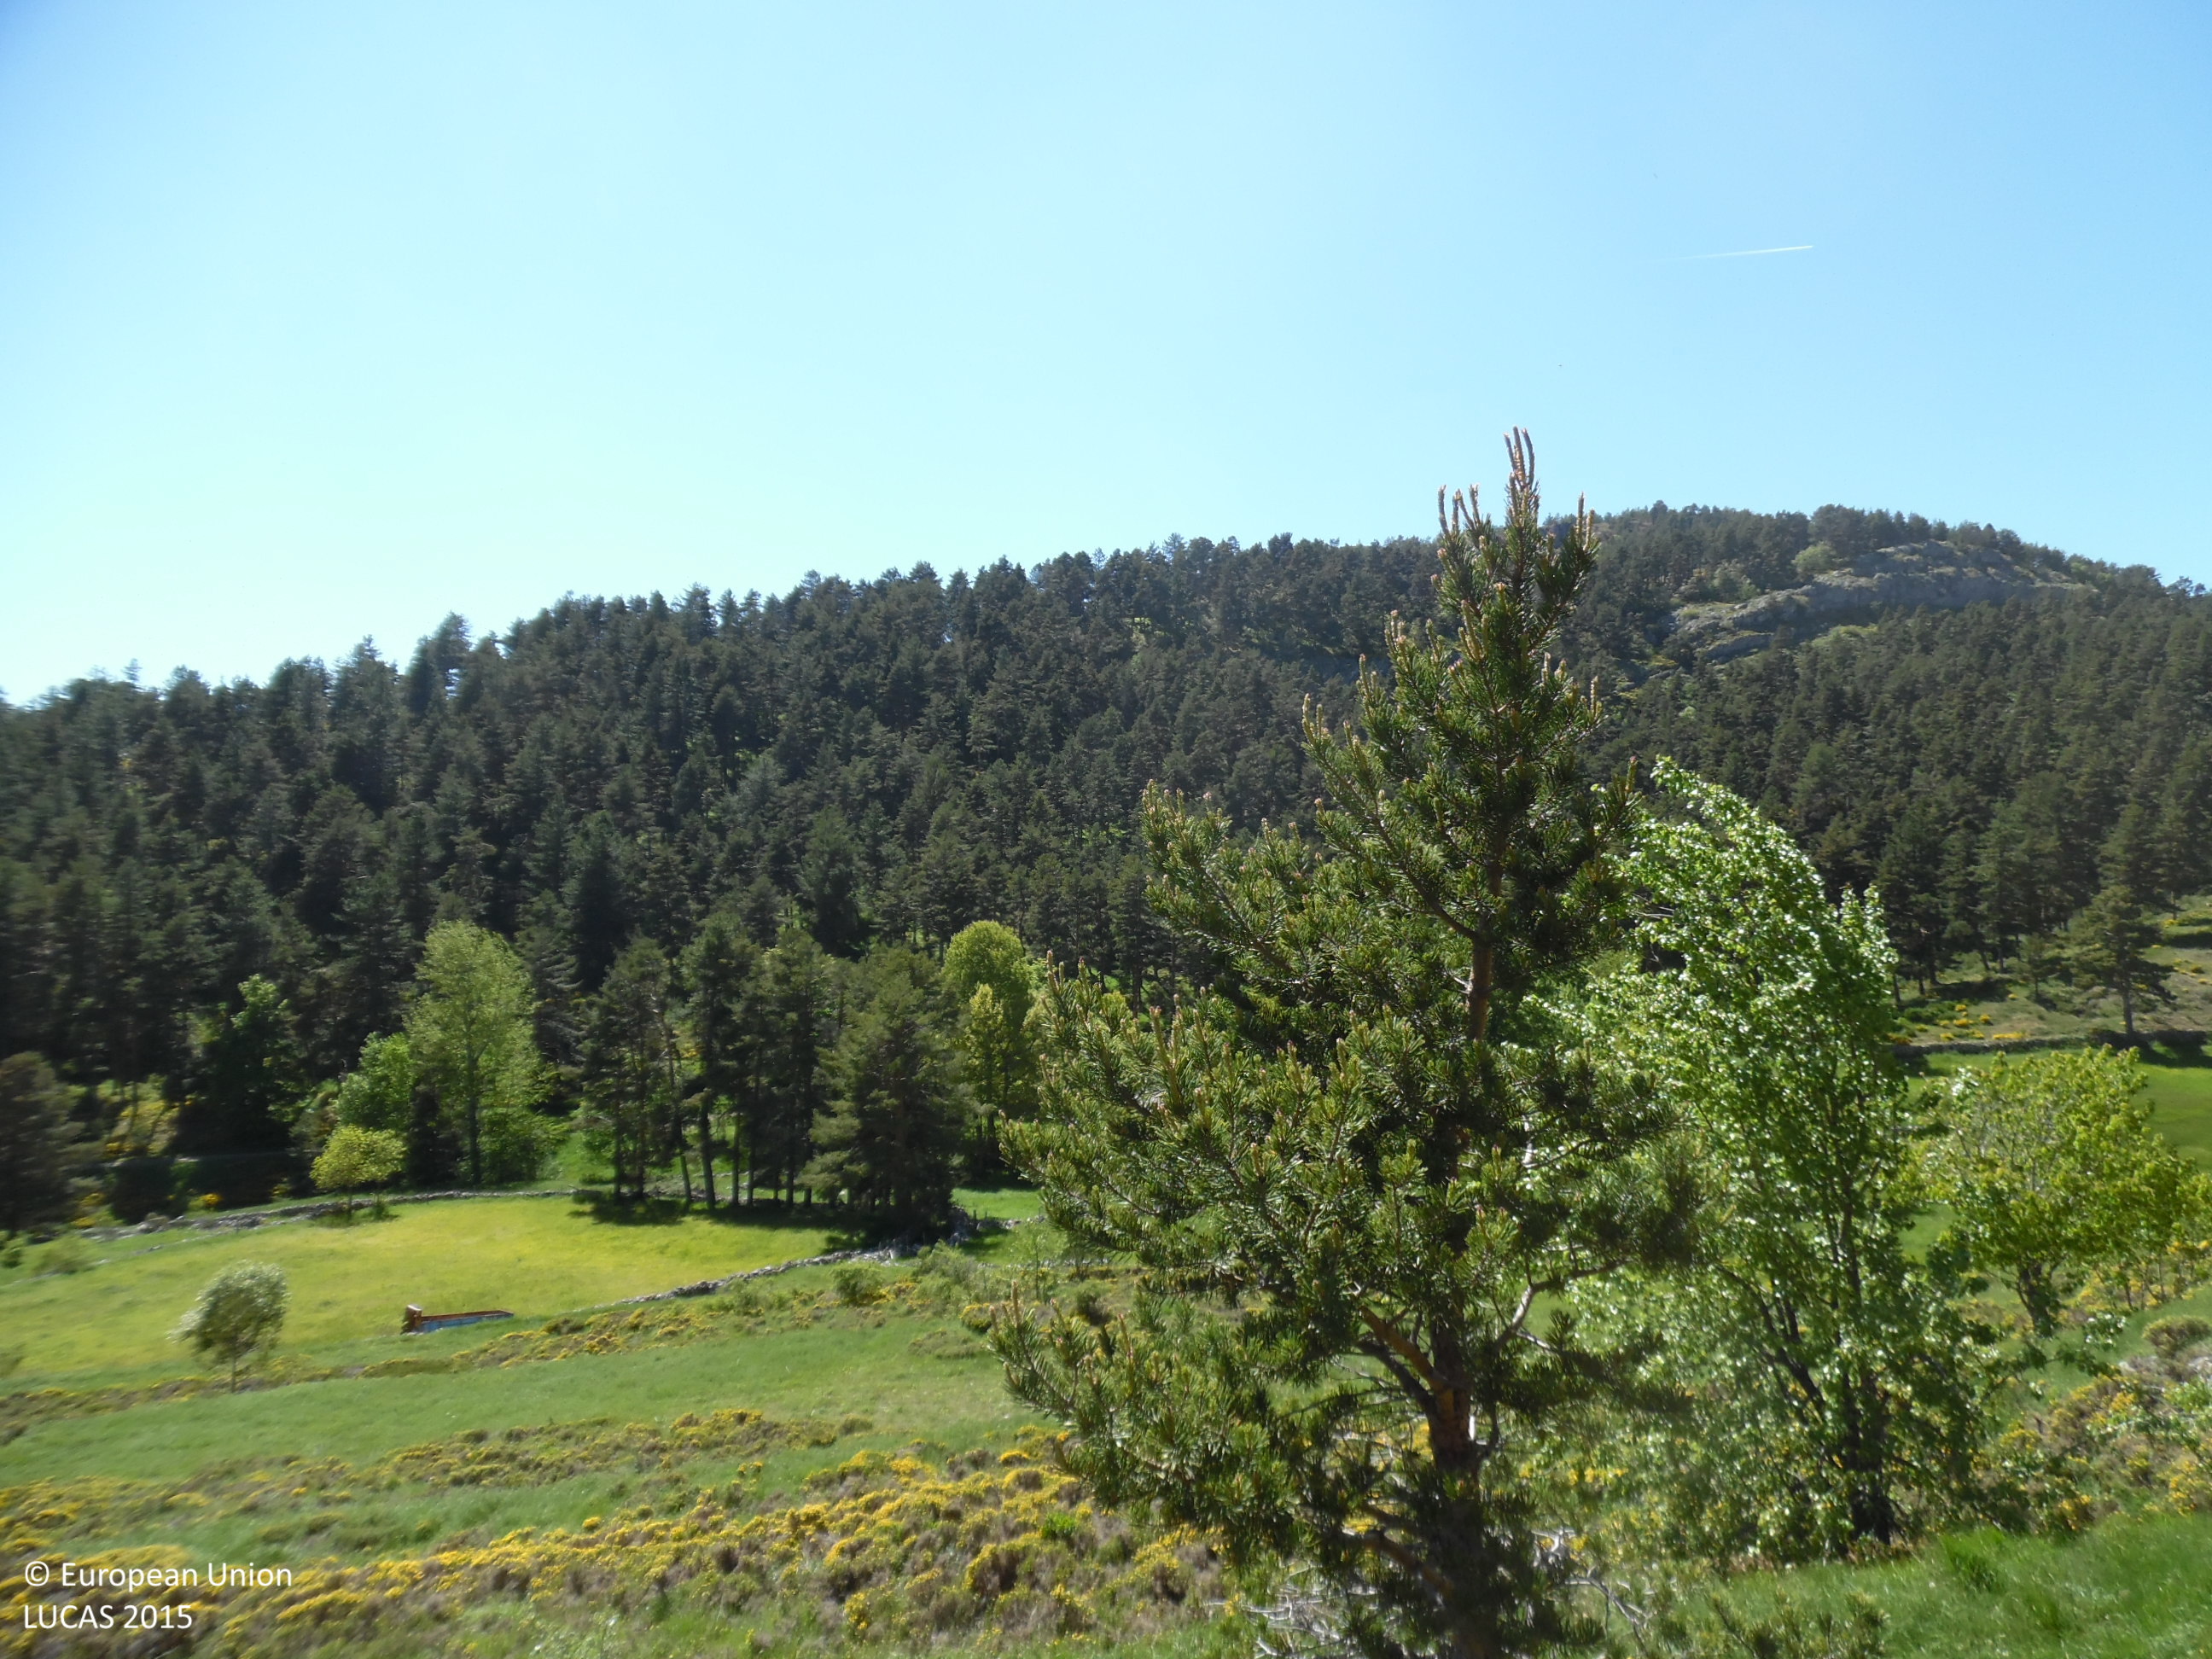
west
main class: Shrubland
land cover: Shrubland without tree cover
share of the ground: > 75 %
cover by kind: shrubs 100 %
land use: Semi-natural and natural areas not in use
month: May
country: ES
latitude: 42.9593
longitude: -6.1863
